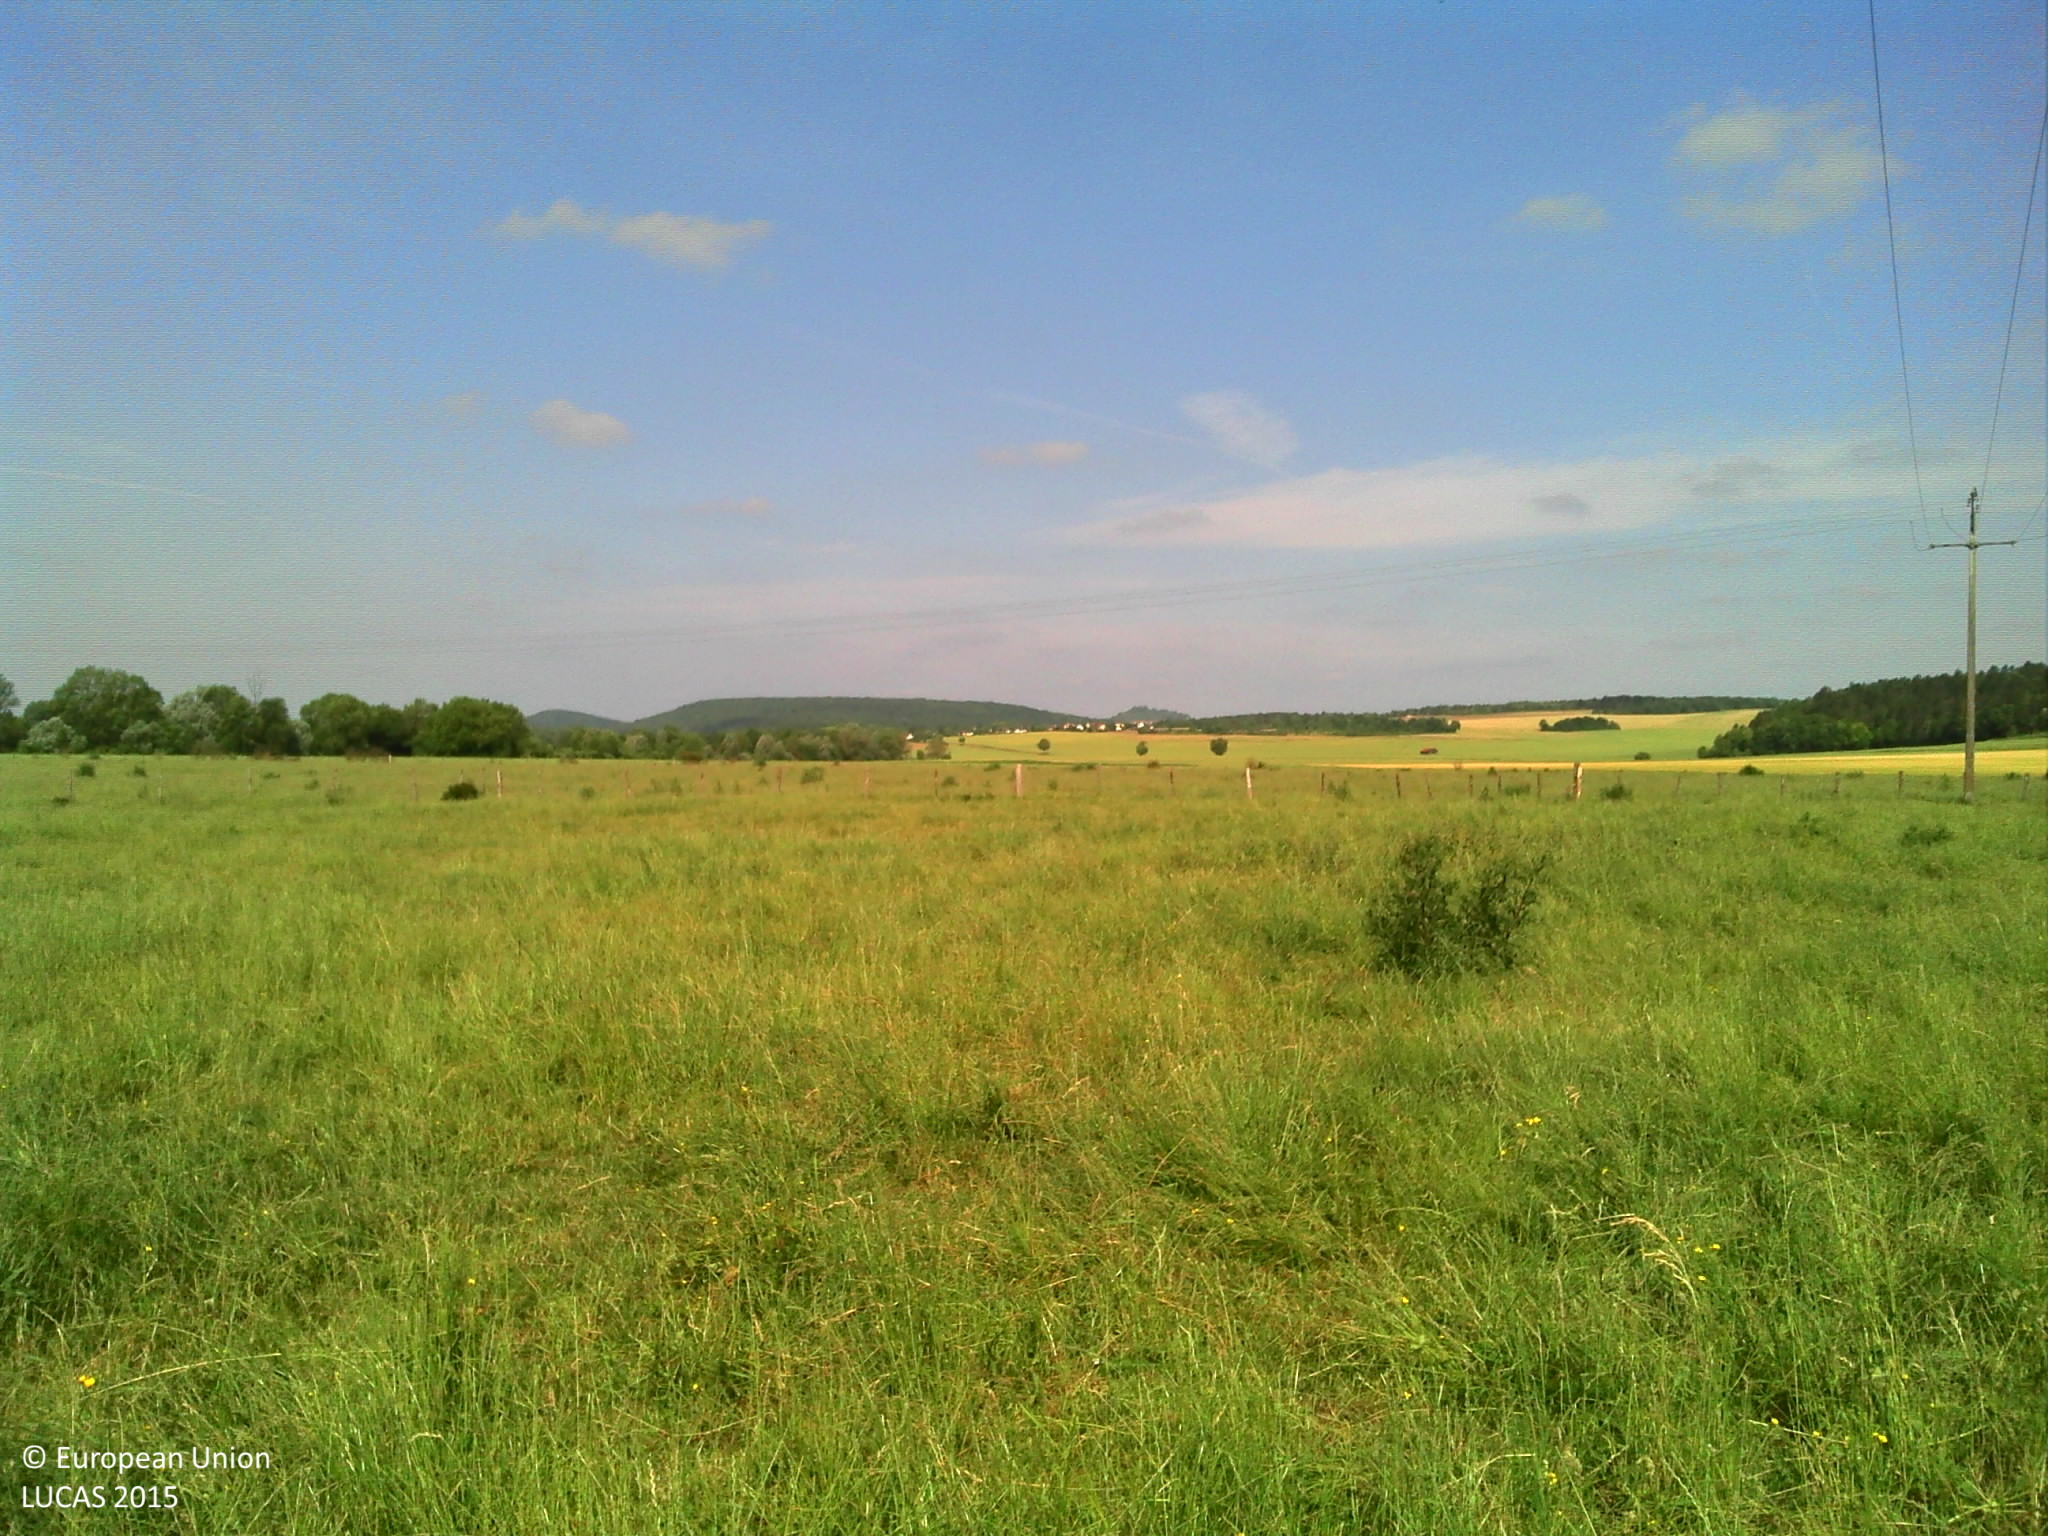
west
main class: Grassland
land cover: Grassland without tree/shrub cover
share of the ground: > 75 %
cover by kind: herbaceous plants 95 %, shrubs 5 %
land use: Agriculture (excluding fallow land and kitchen gardens)
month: June
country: FR
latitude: 47.5196
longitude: 5.0998
